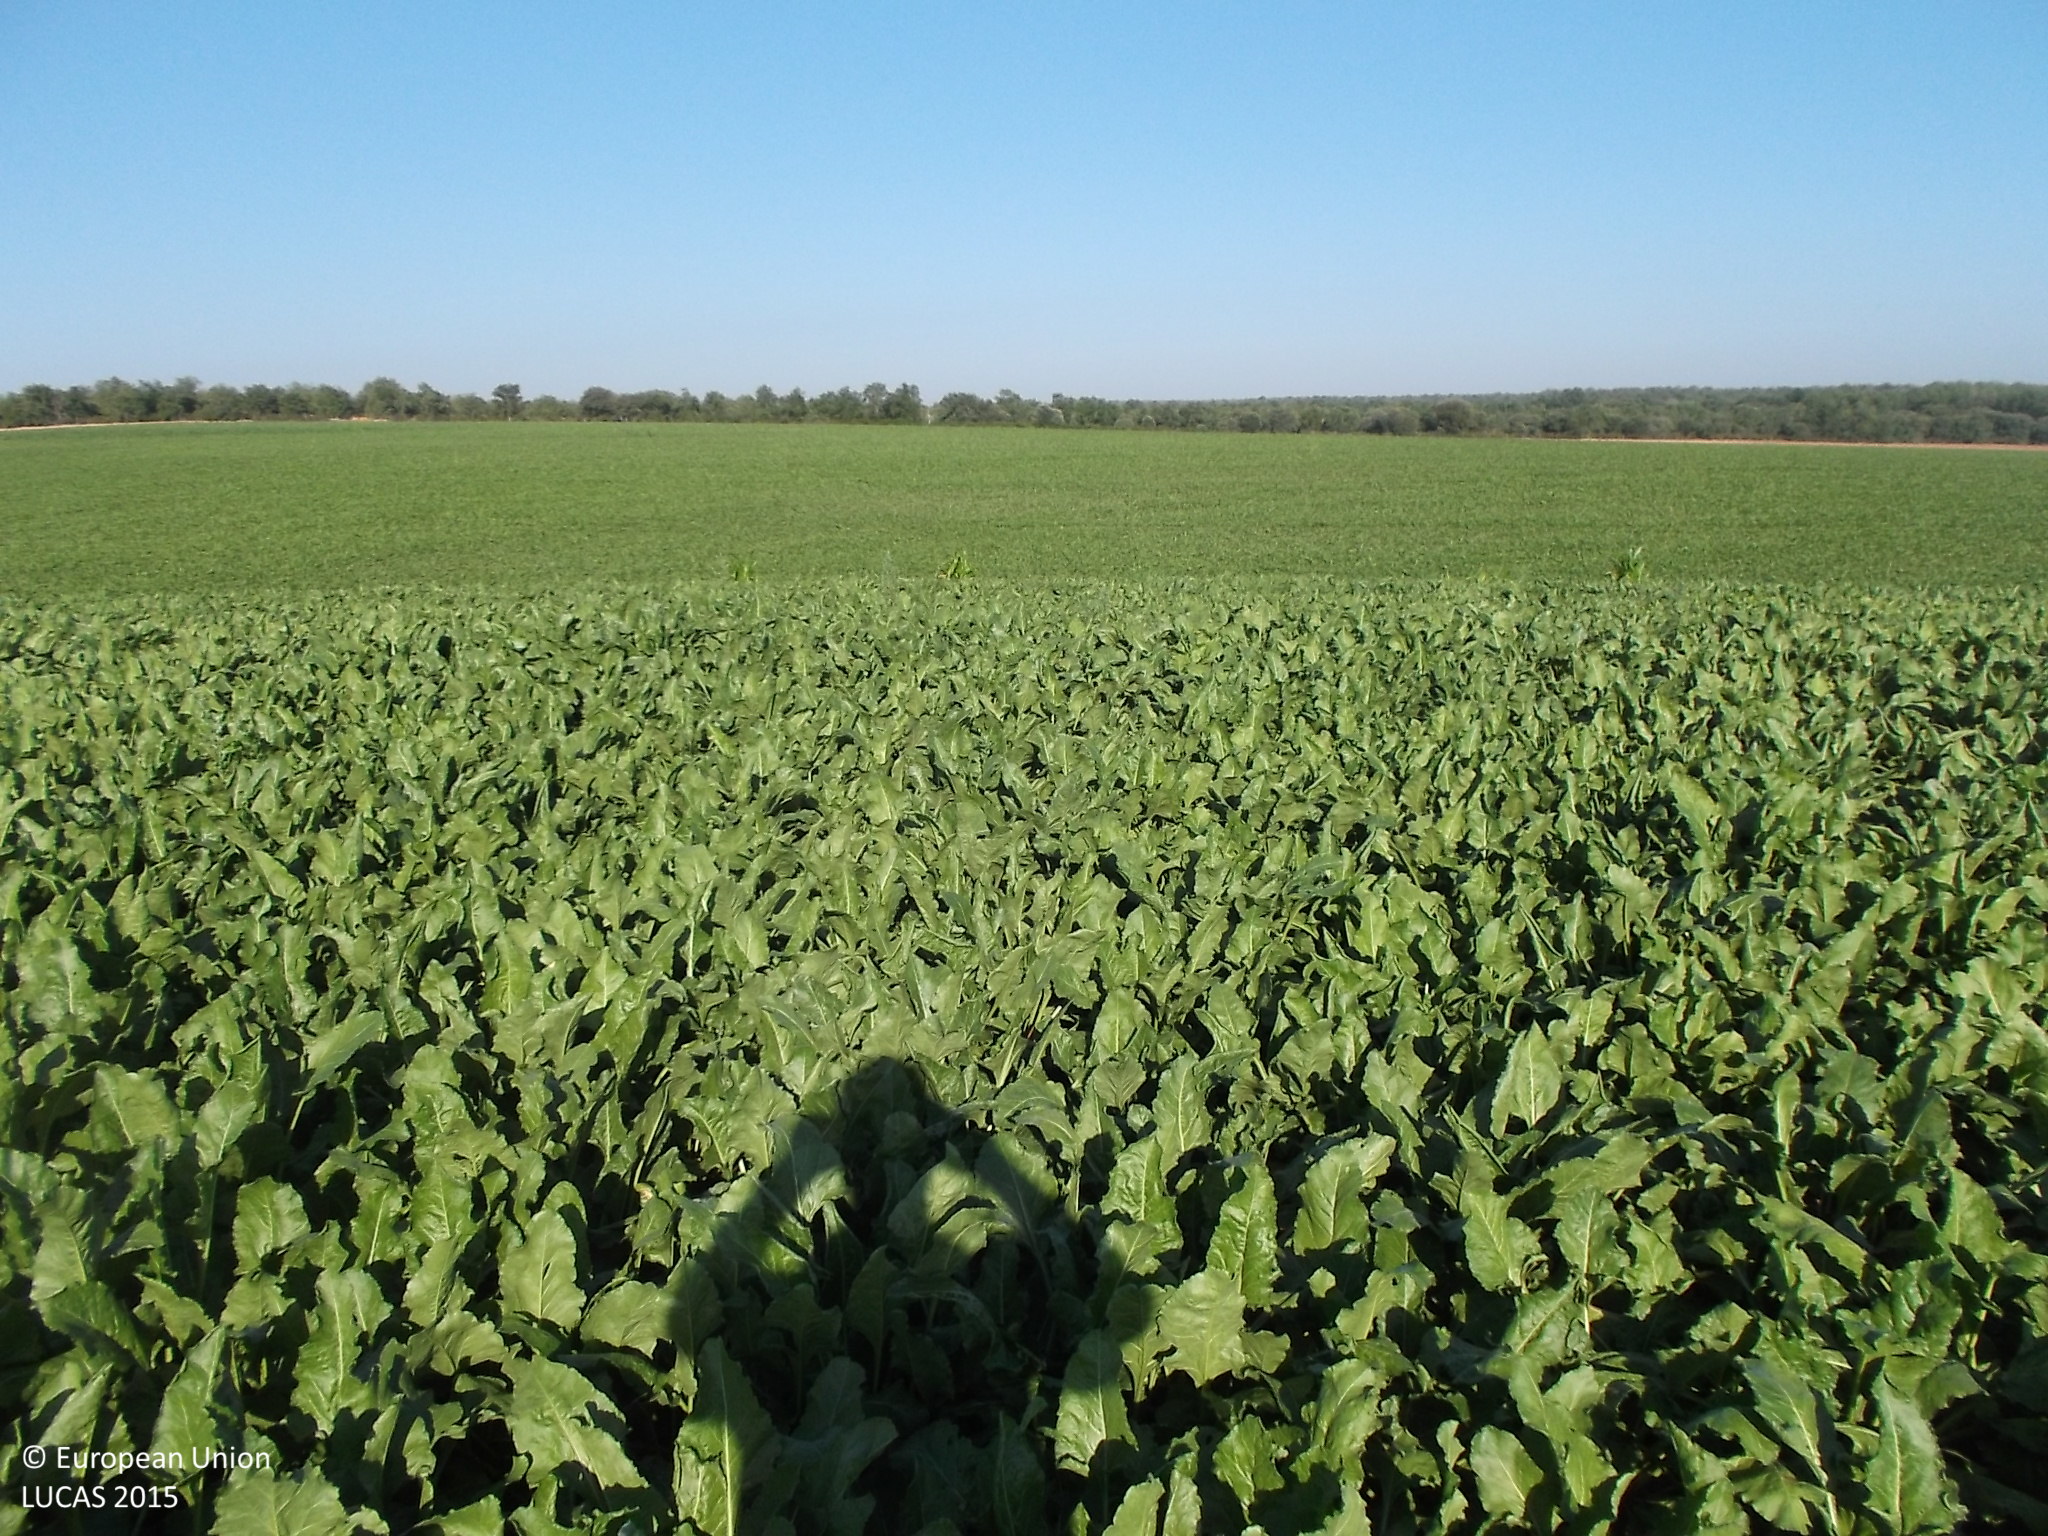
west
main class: Cropland
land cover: Sugar beet
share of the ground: > 75 %
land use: Agriculture (excluding fallow land and kitchen gardens)
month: July
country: ES
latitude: 41.2649
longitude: -5.7558
